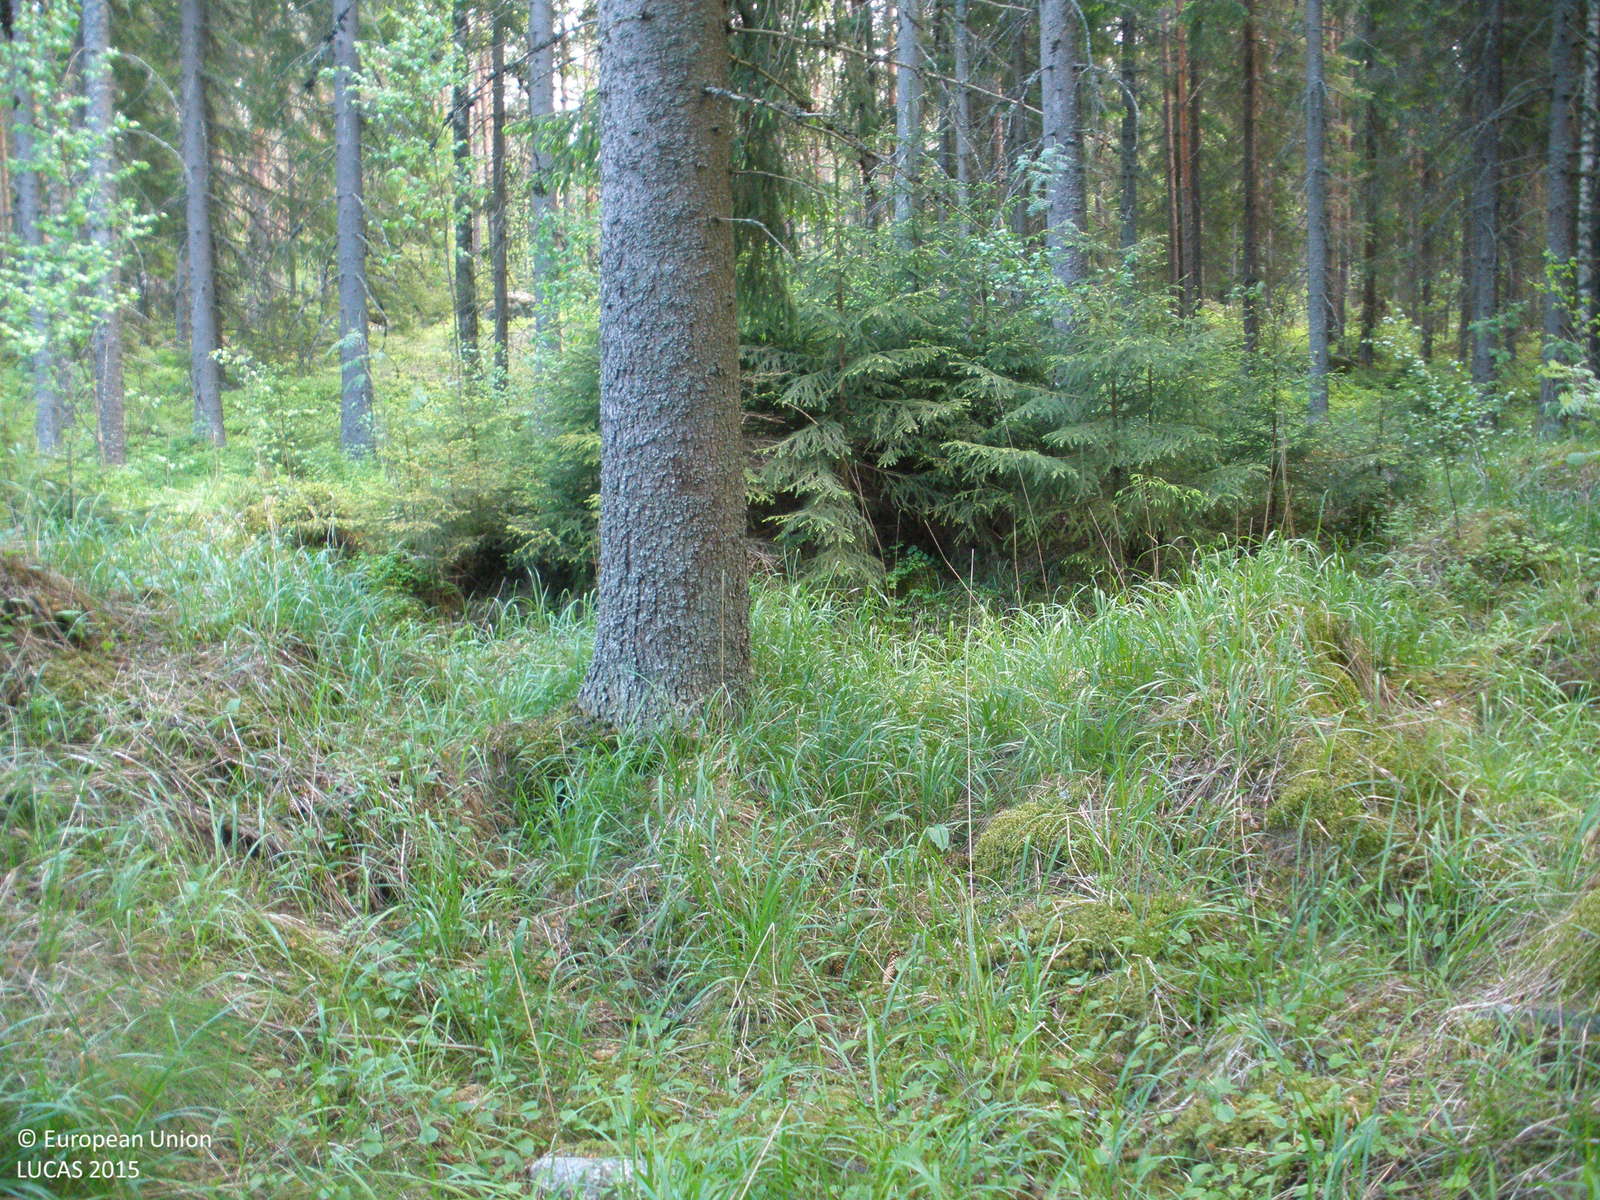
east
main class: Woodland
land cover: Spruce dominated mixed woodland
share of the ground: > 75 %
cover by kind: coniferous forest trees 70 %, broadleaved forest trees 25 %, shrubs 5 %
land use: Forestry
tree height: > 5 m
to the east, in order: Spruce dominated mixed woodland; Ditches and canals; Spruce dominated mixed woodland; Pine dominated coniferous woodland; Pine dominated mixed woodland
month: June
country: FI
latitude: 60.5674
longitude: 23.3465
